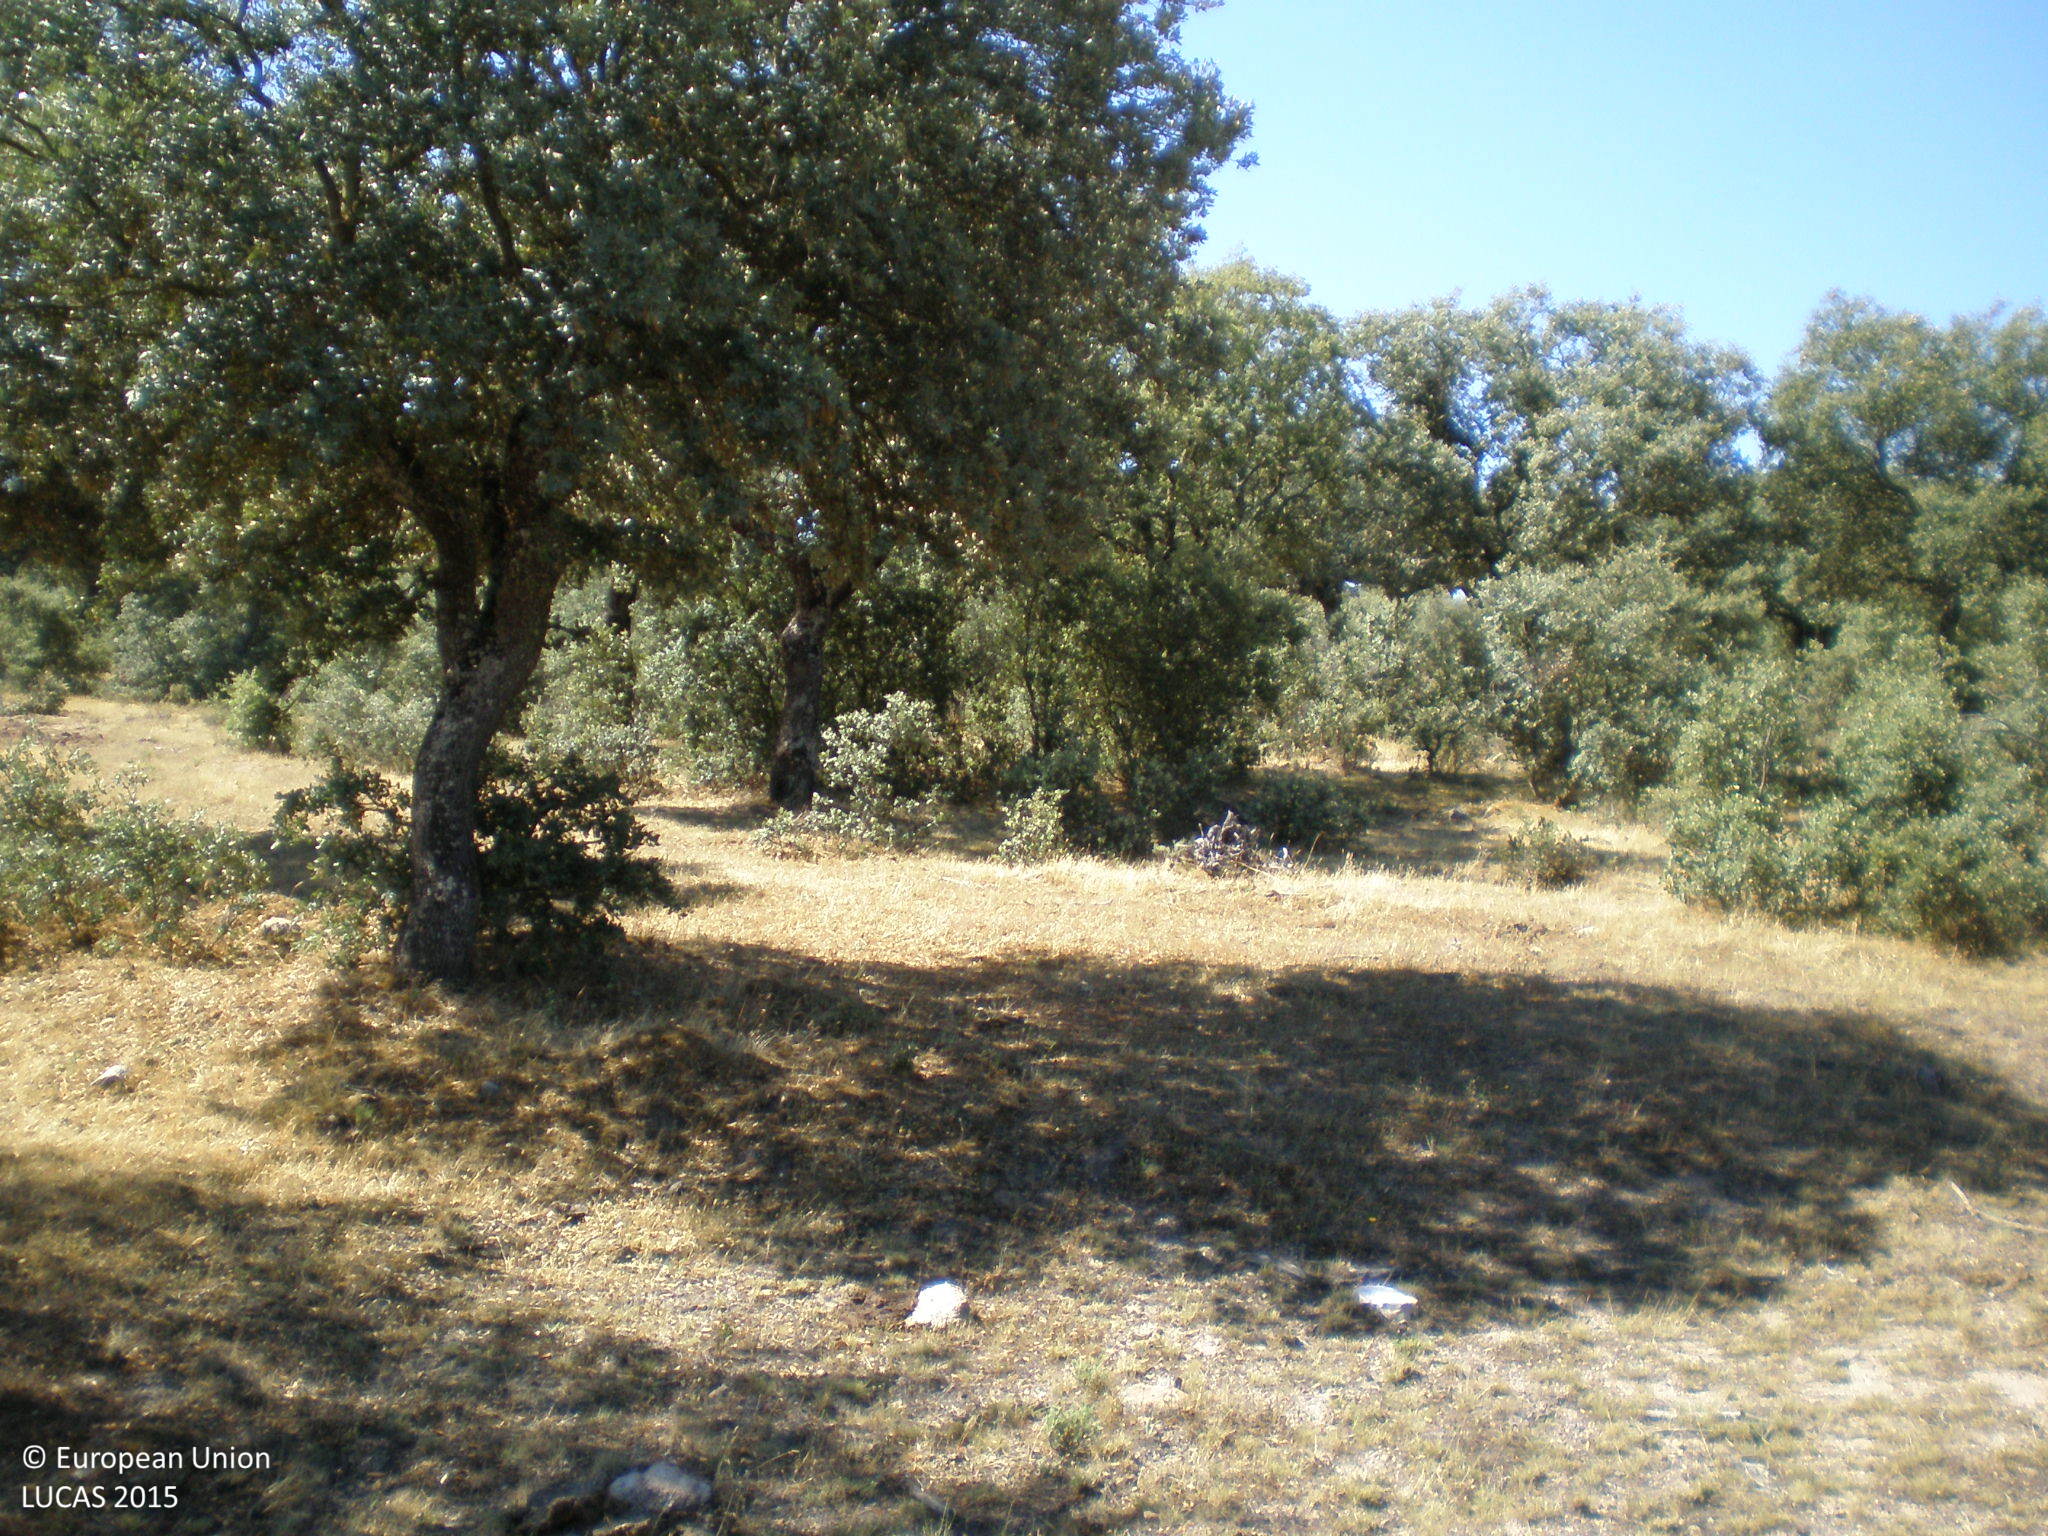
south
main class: Woodland
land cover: Broadleaved woodland
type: broadleaved evergreen forest
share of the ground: 25 - 50 %
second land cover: Grassland without tree/shrub cover
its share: 50 - 75 %
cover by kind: herbaceous plants 65 %, broadleaved forest trees 35 %
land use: Forestry
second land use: Agriculture (excluding fallow land and kitchen gardens)
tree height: > 5 m
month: June
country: ES
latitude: 40.8200
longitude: -5.6662
